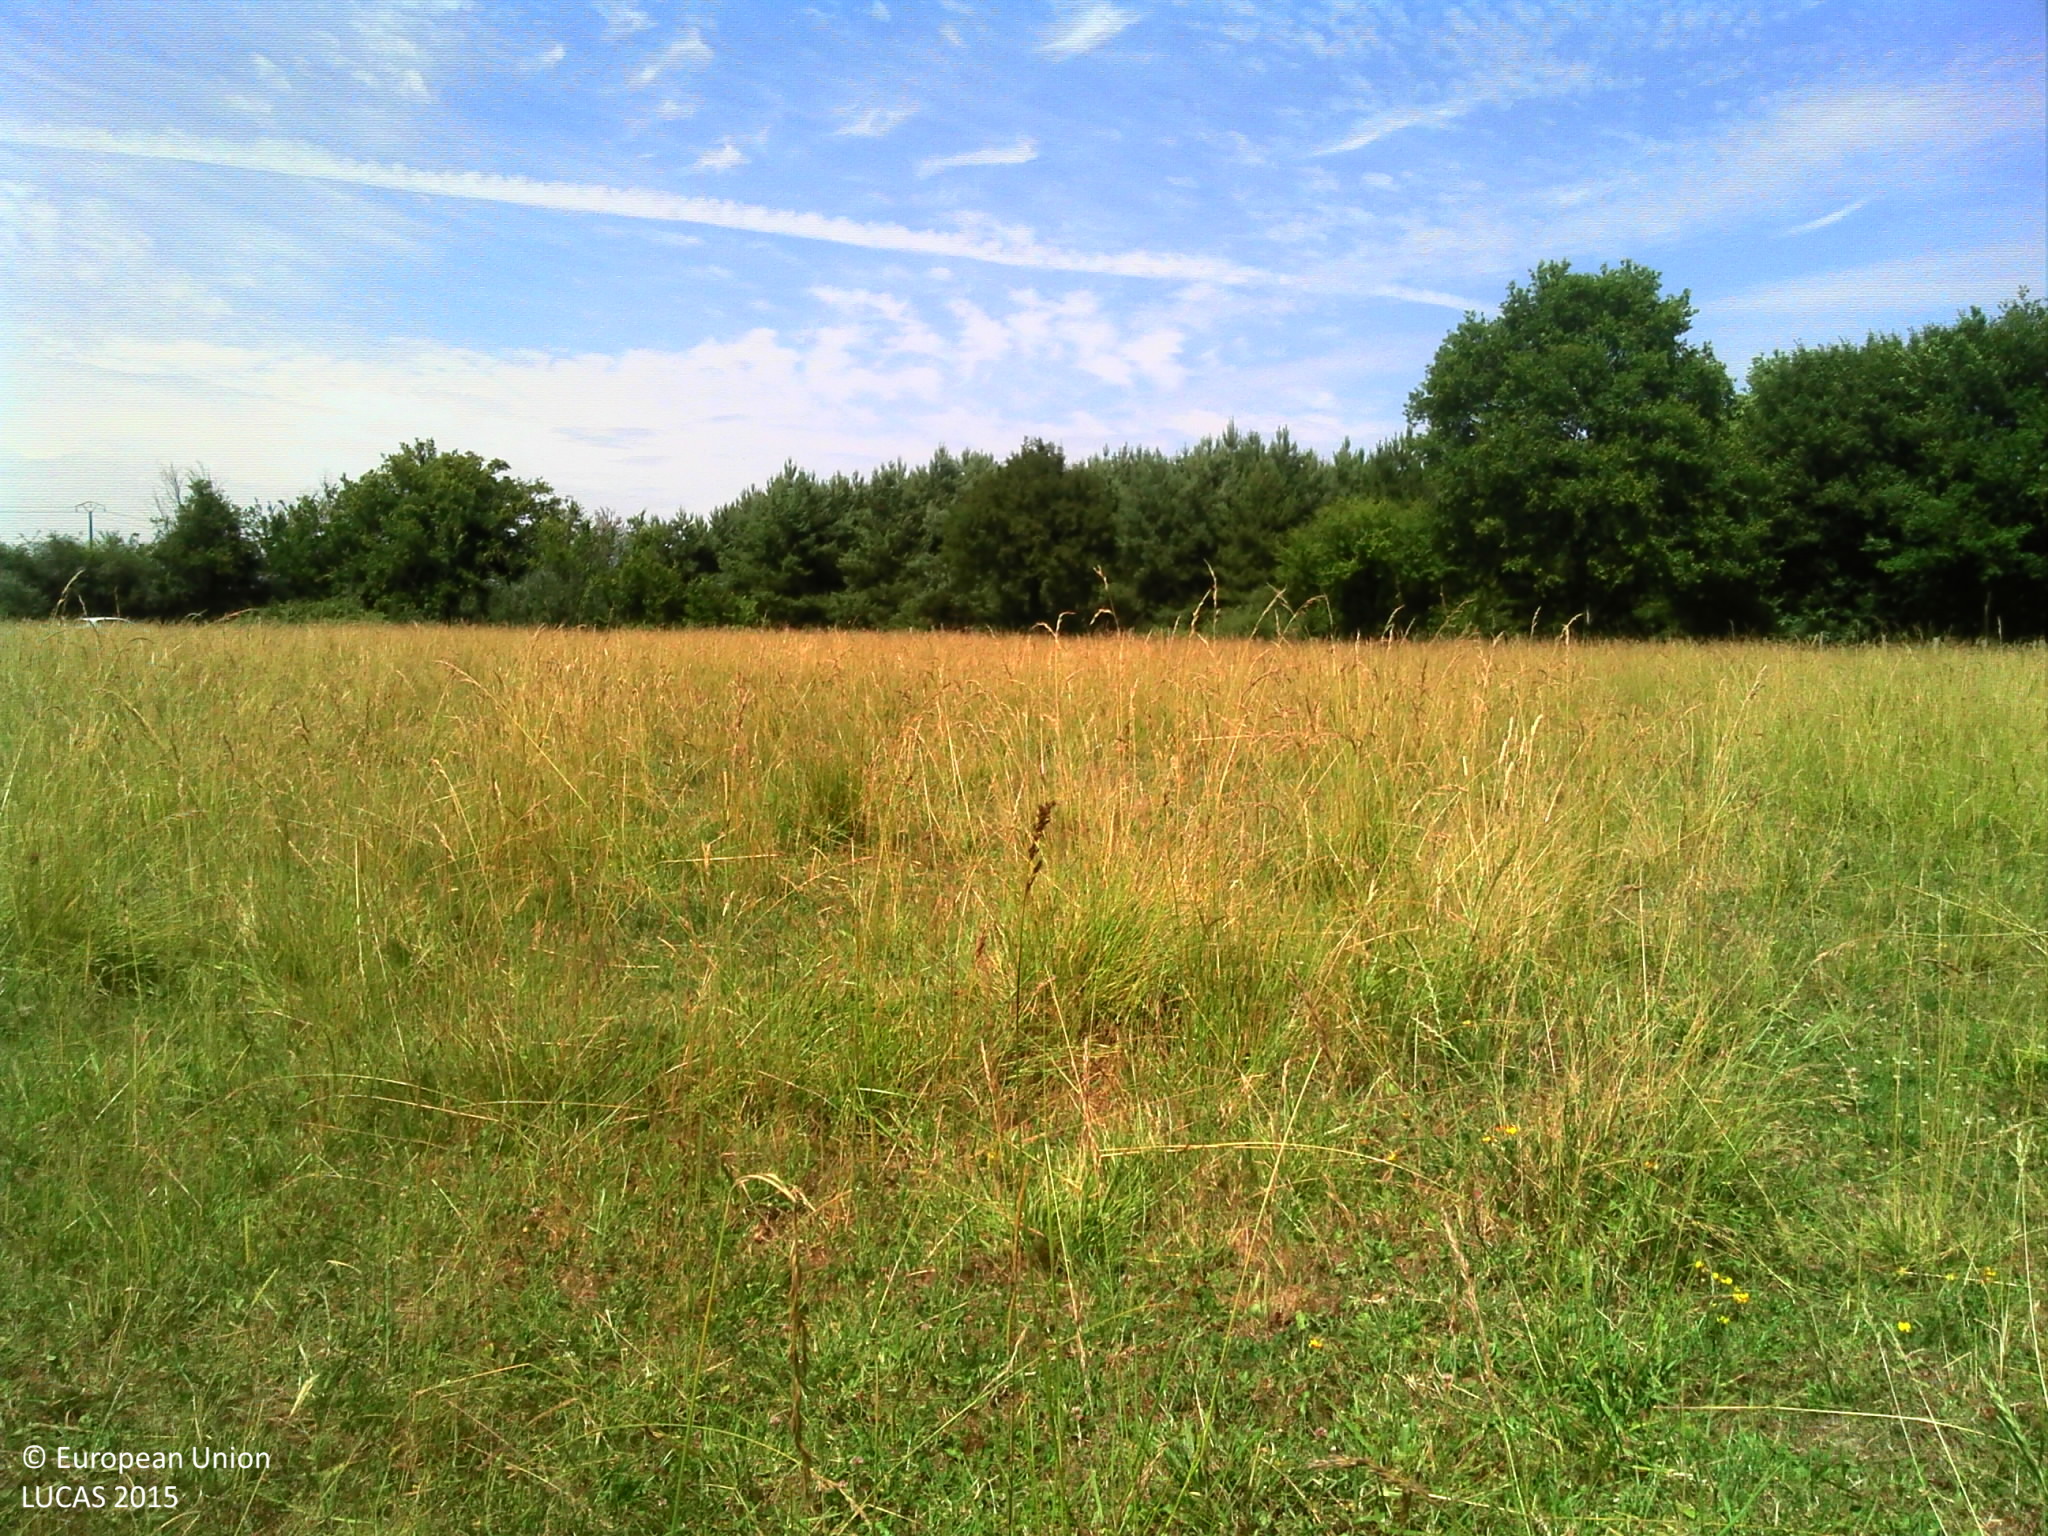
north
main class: Grassland
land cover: Grassland without tree/shrub cover
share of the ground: > 75 %
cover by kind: herbaceous plants 100 %
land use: Agriculture (excluding fallow land and kitchen gardens)
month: June
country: FR
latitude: 47.5071
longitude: 0.3246
